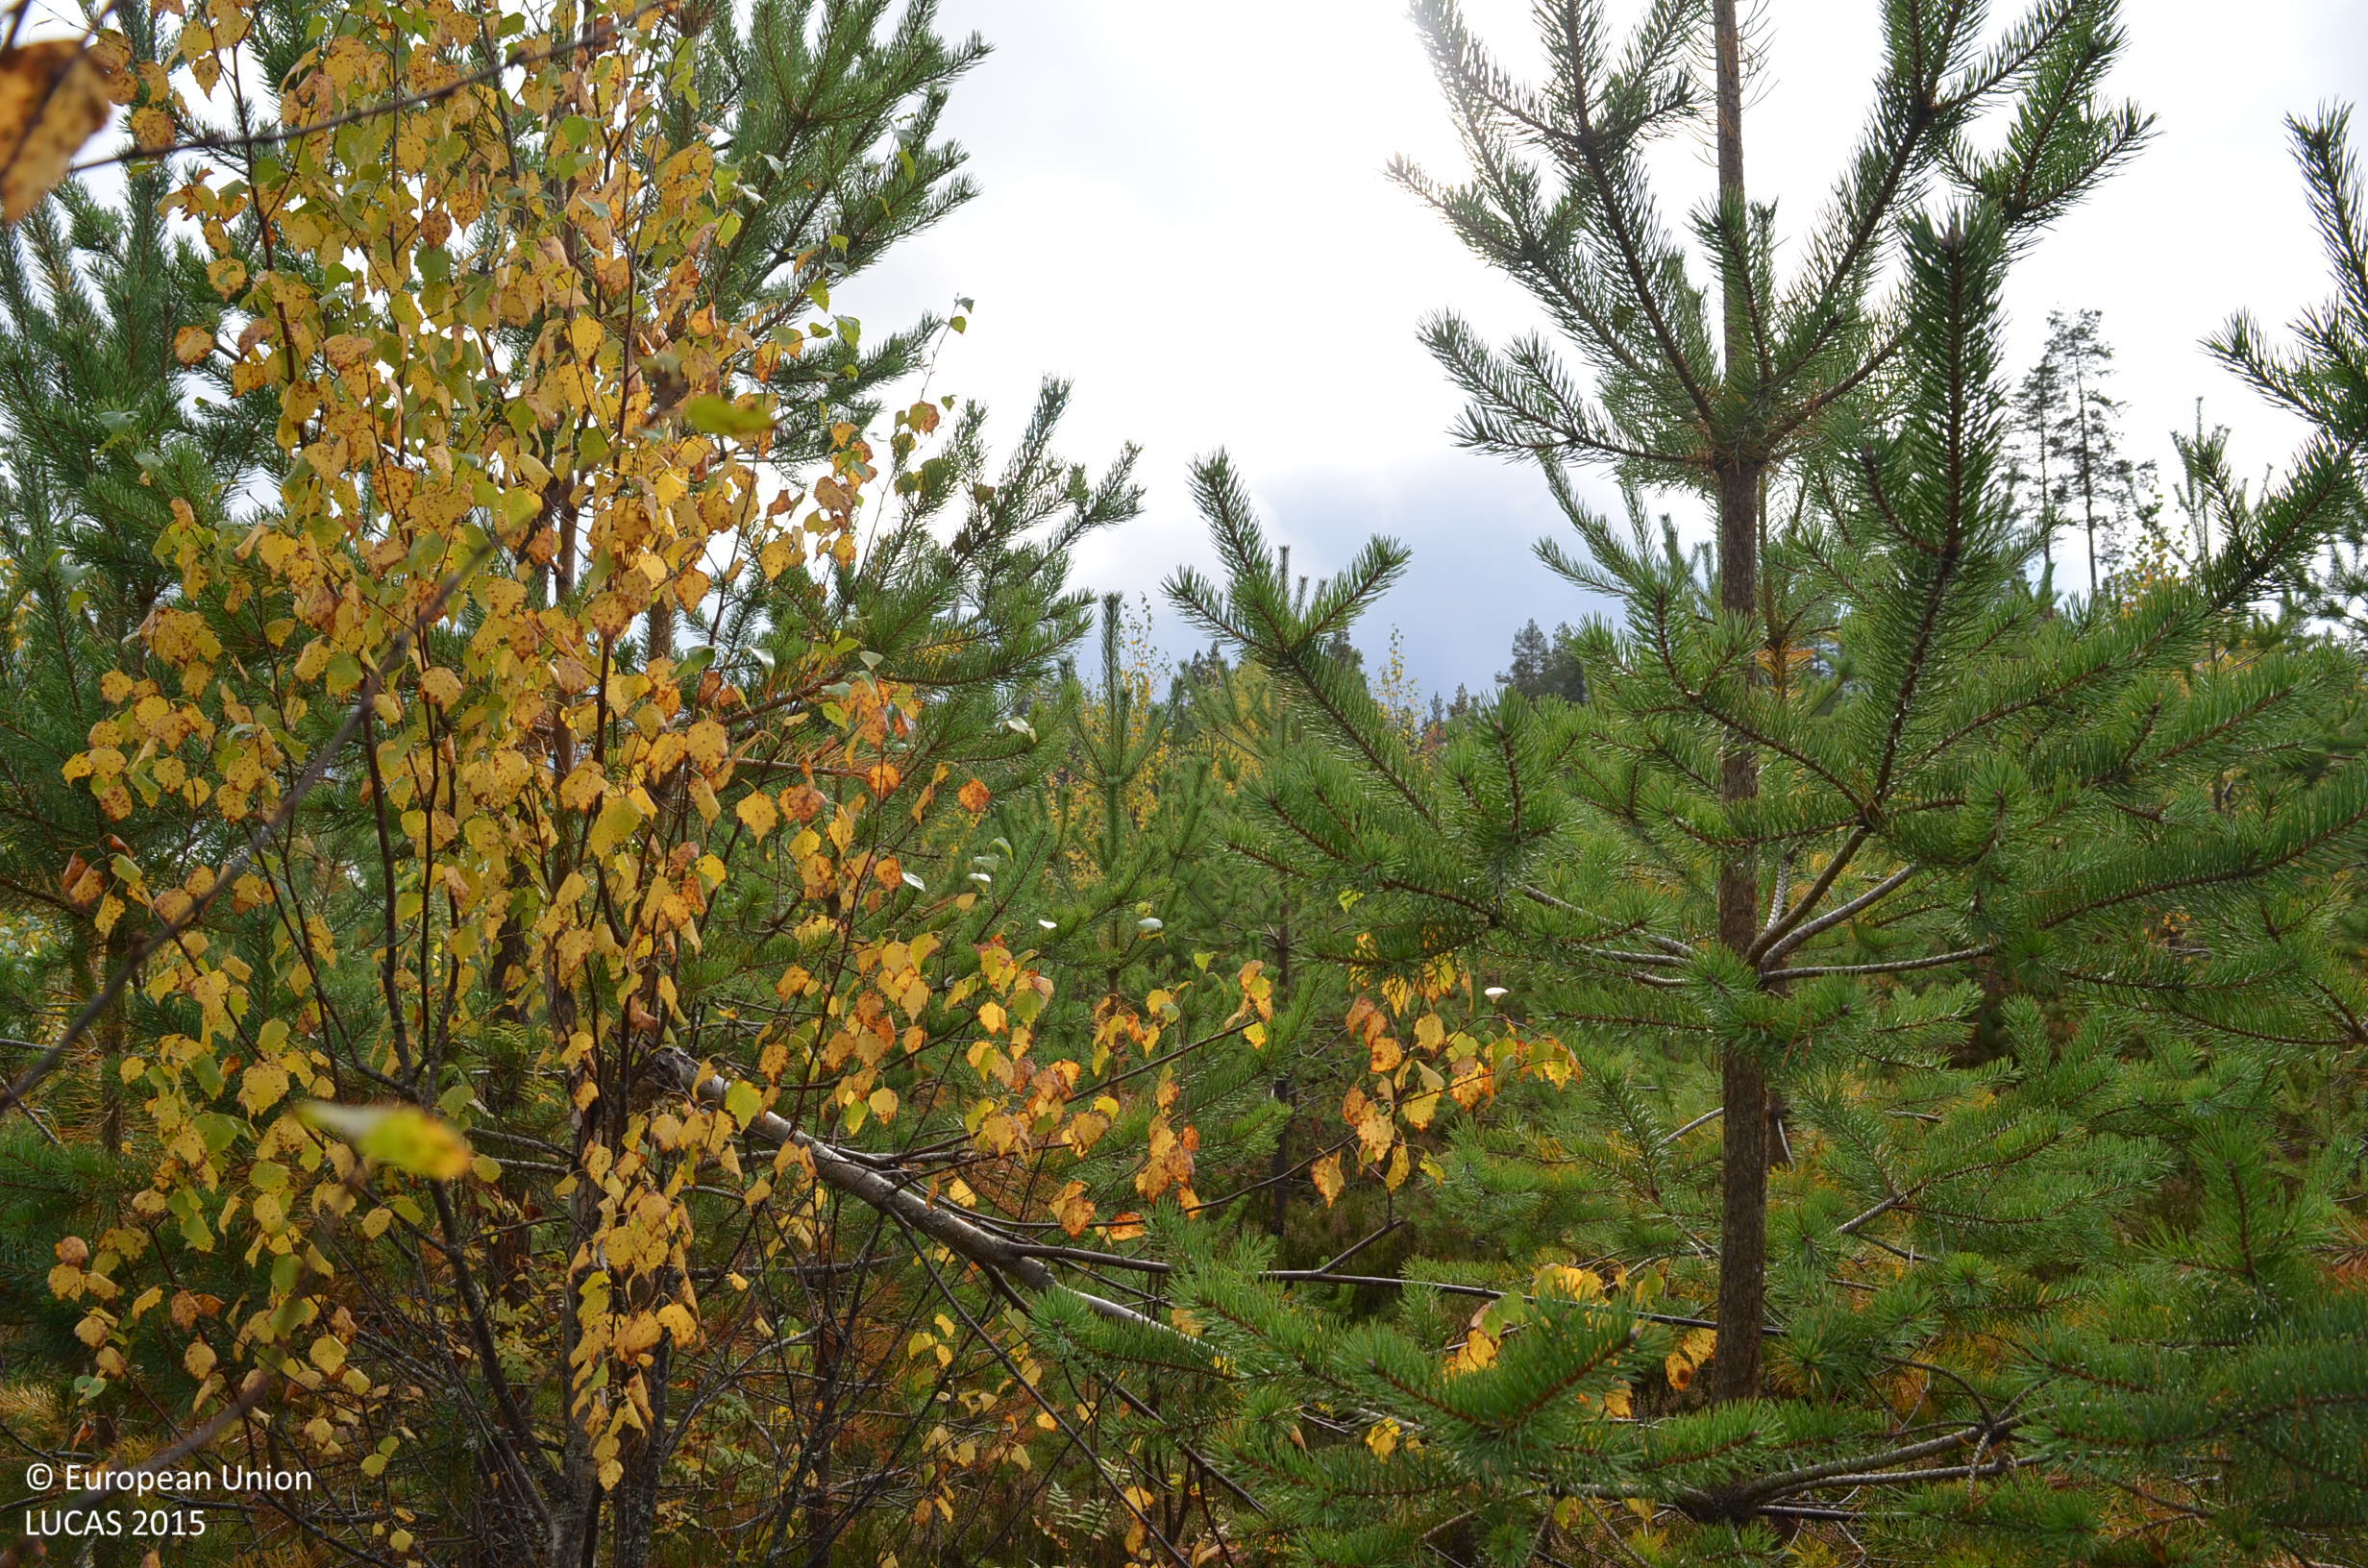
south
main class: Woodland
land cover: Pine dominated mixed woodland
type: boreal forest
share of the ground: 50 - 75 %
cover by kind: coniferous forest trees 35 %, shrubs 30 %, broadleaved forest trees 25 %, lichens and mosses 10 %
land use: Forestry
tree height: < 5 m
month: September
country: FI
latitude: 62.7269
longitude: 23.7865
